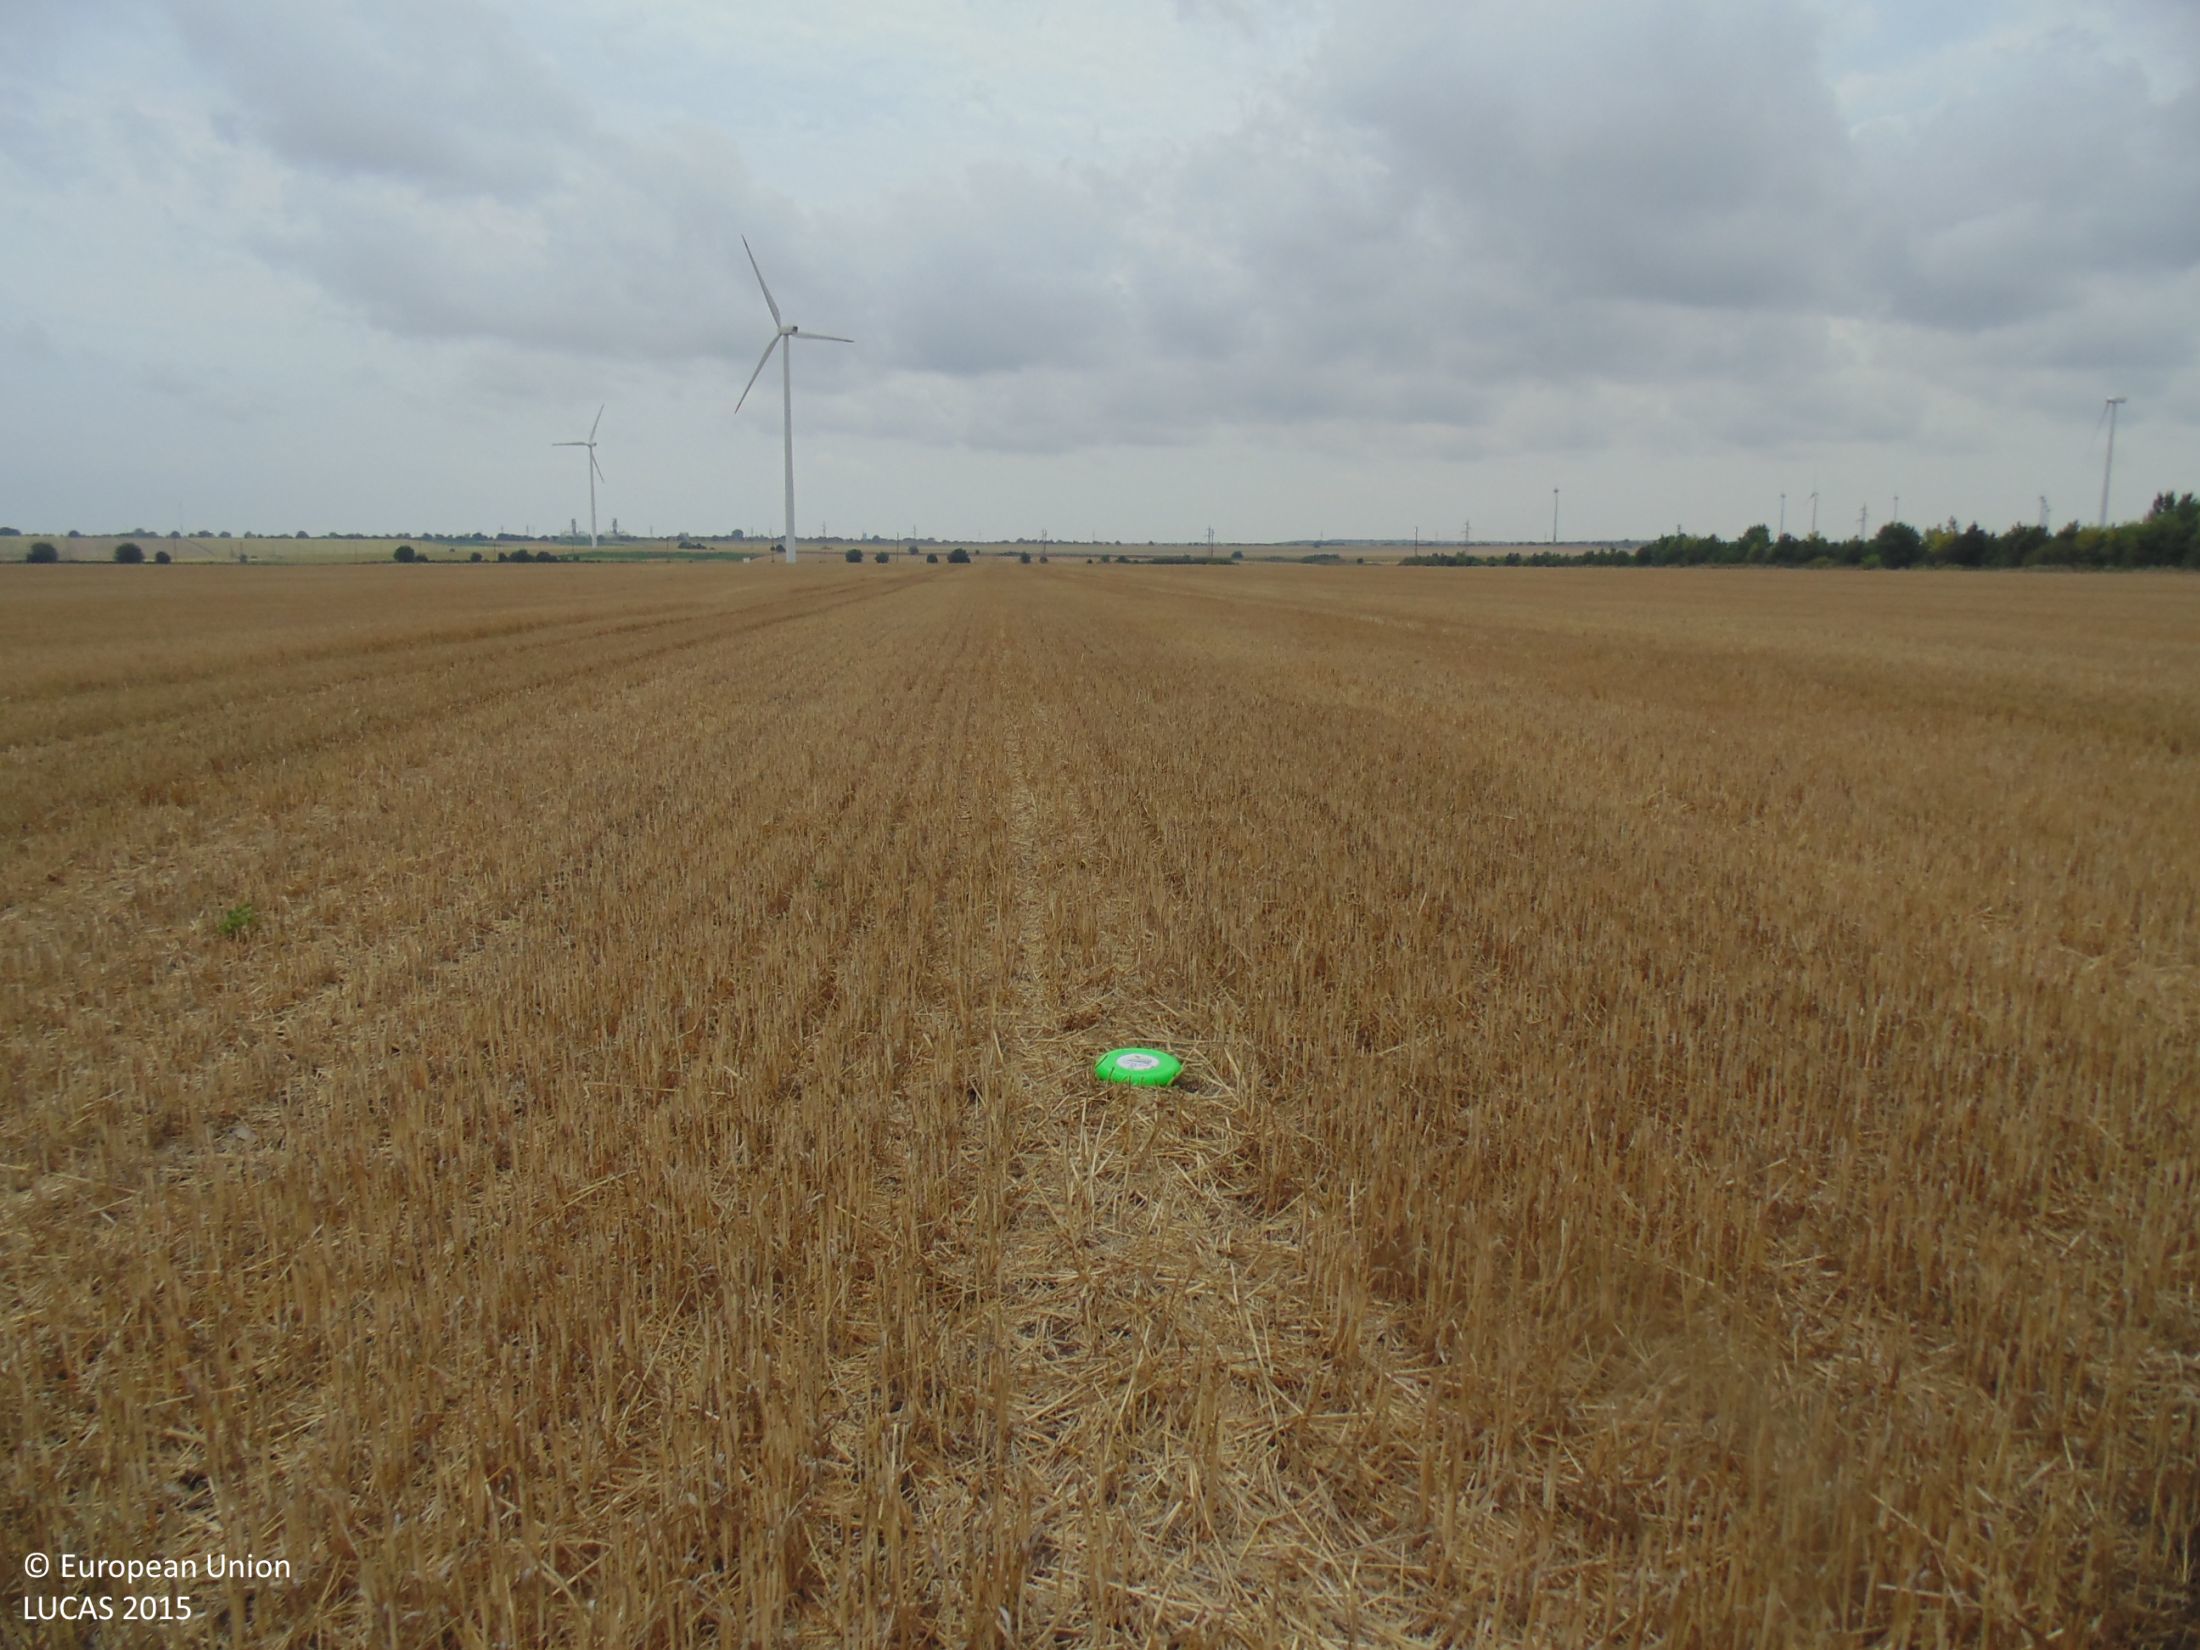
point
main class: Cropland
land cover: Common wheat
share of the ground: 25 - 50 %
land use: Agriculture (excluding fallow land and kitchen gardens)
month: August
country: BG
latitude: 43.5565
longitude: 28.4949
